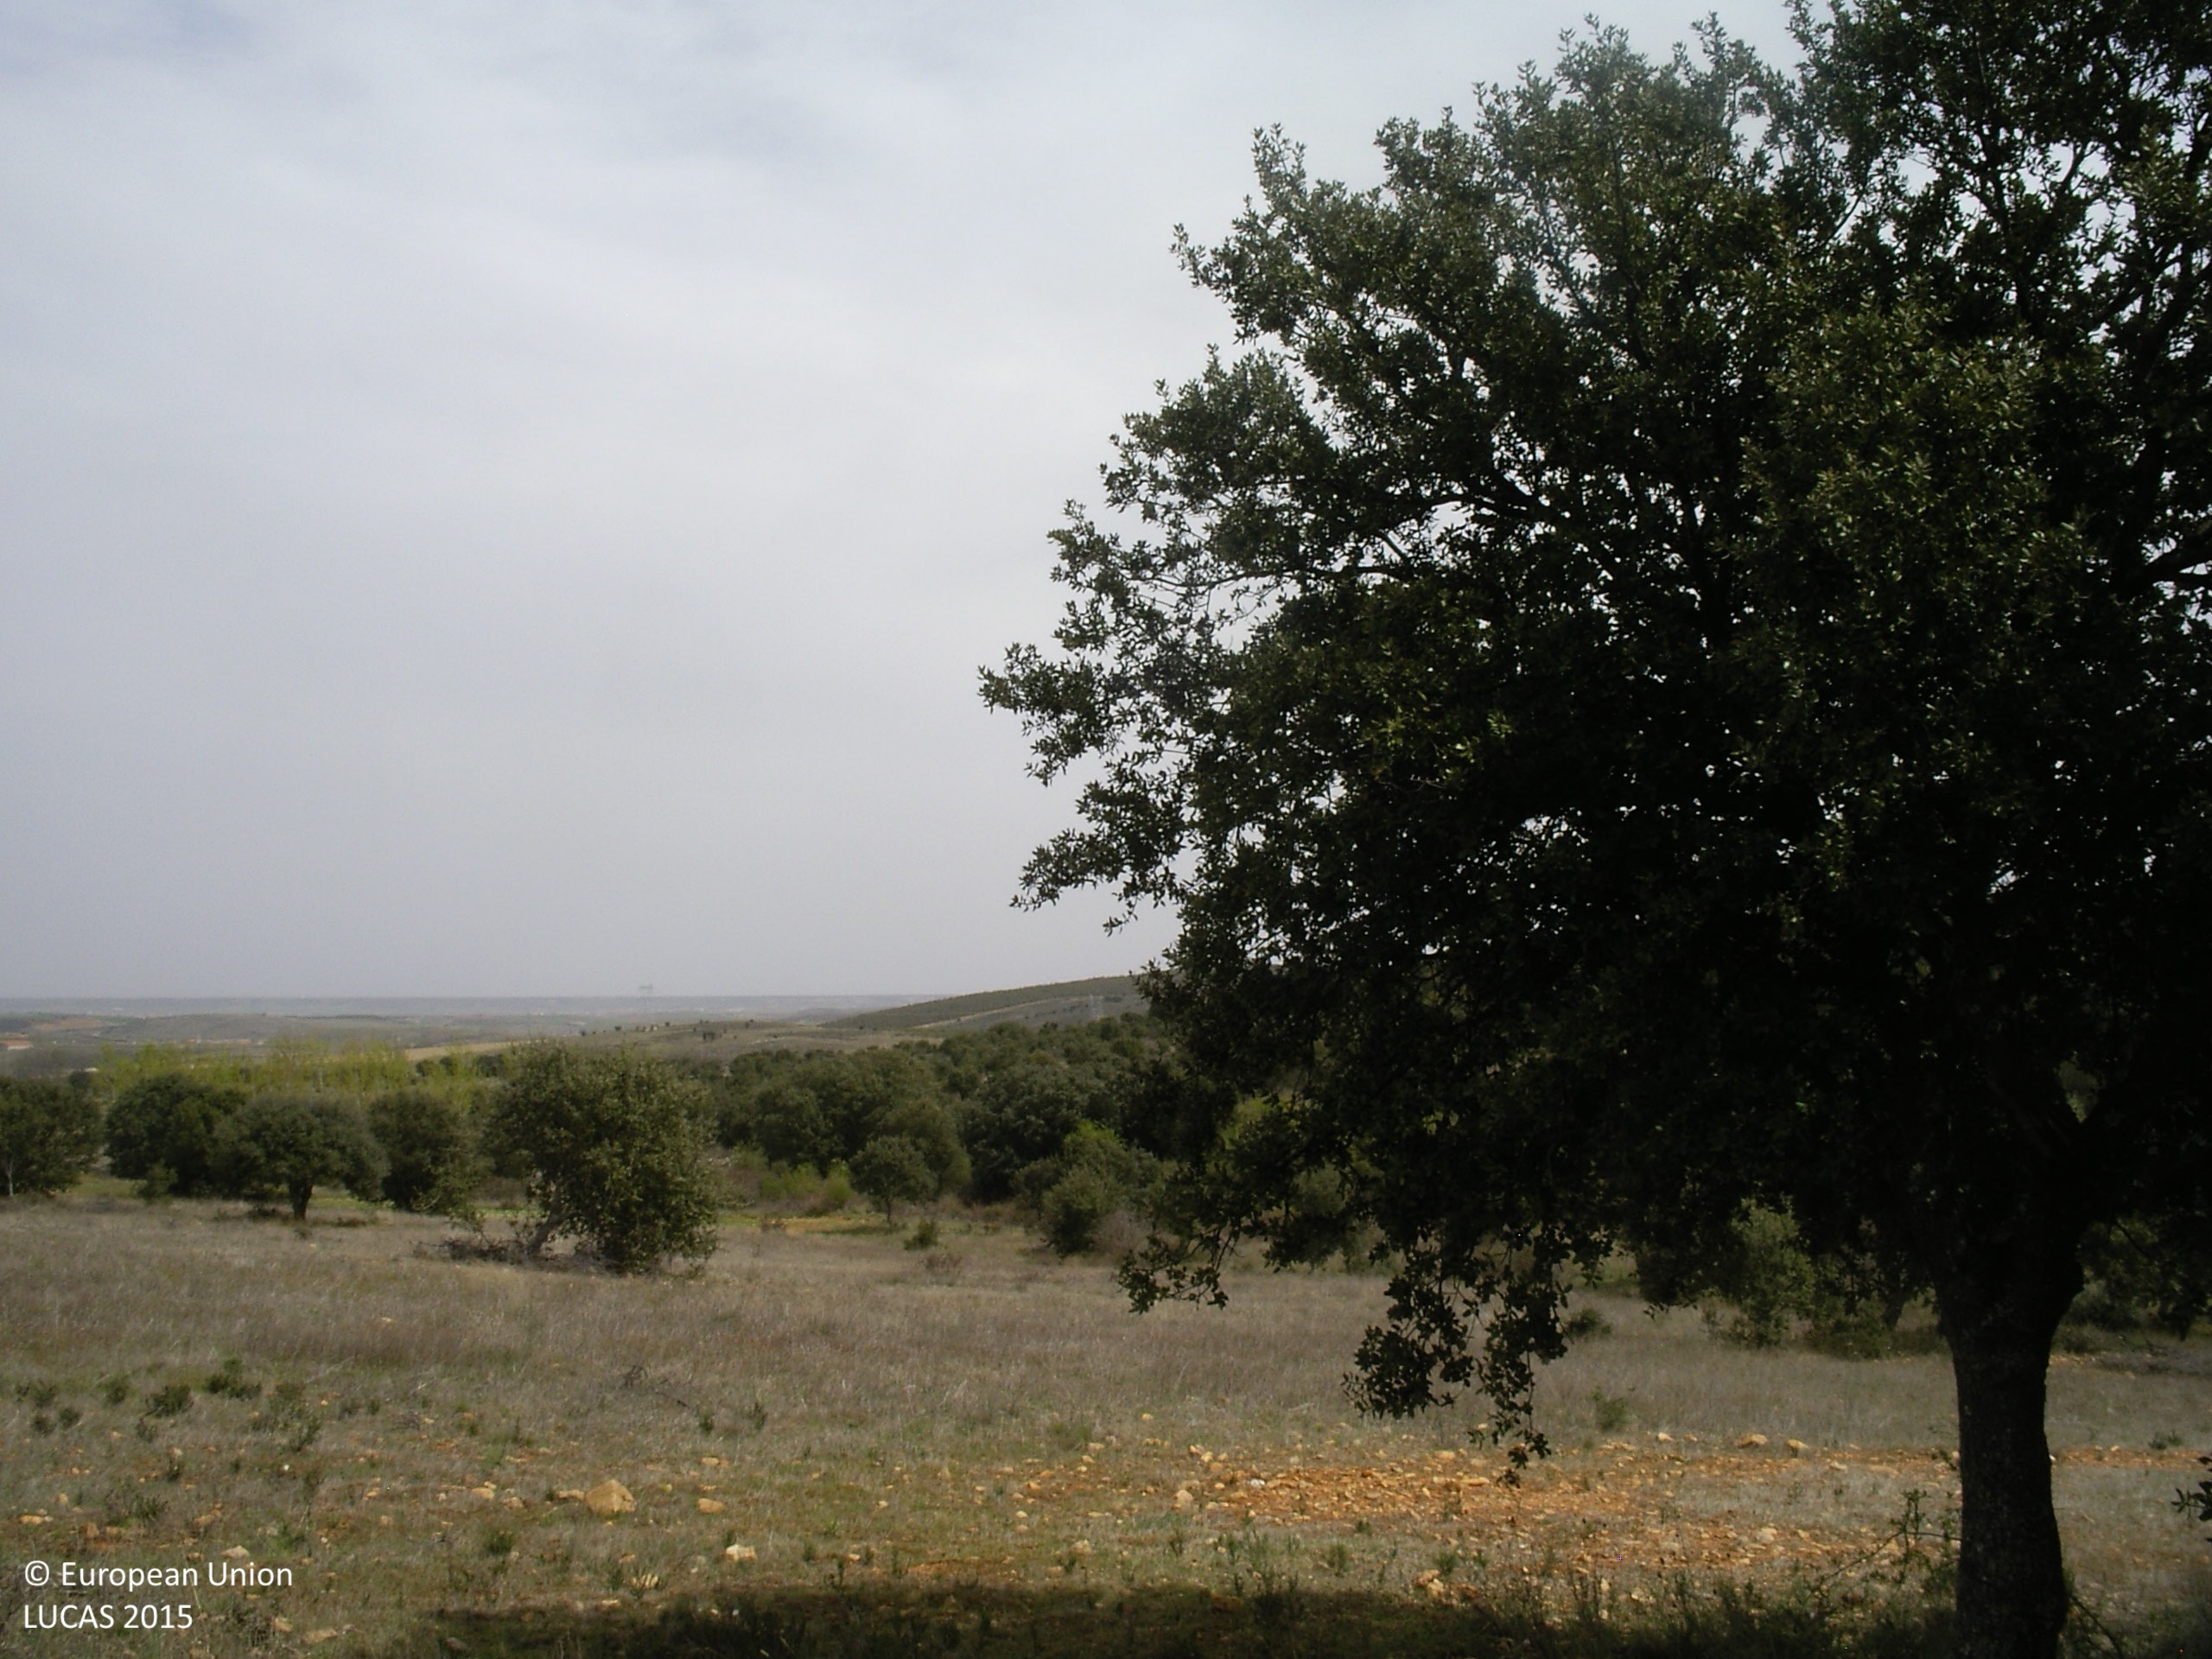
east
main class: Shrubland
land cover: Shrubland with sparse tree cover
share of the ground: > 75 %
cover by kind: herbaceous plants 85 %, shrubs 10 %, broadleaved forest trees 5 %
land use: Agriculture (excluding fallow land and kitchen gardens)
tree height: > 5 m
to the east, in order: Shrubland with sparse tree cover; Spontaneously vegetated surfaces; Grassland with sparse tree/shrub cover; Abandoned hedges; Grassland with sparse tree/shrub cover; Tracks; Grassland with sparse tree/shrub cover; Shrubland with sparse tree cover; Dry stone walls; Broadleaved woodland; Other bare soil; Broadleaved woodland; Shrubland with sparse tree cover
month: April
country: ES
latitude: 42.3987
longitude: -6.1312
